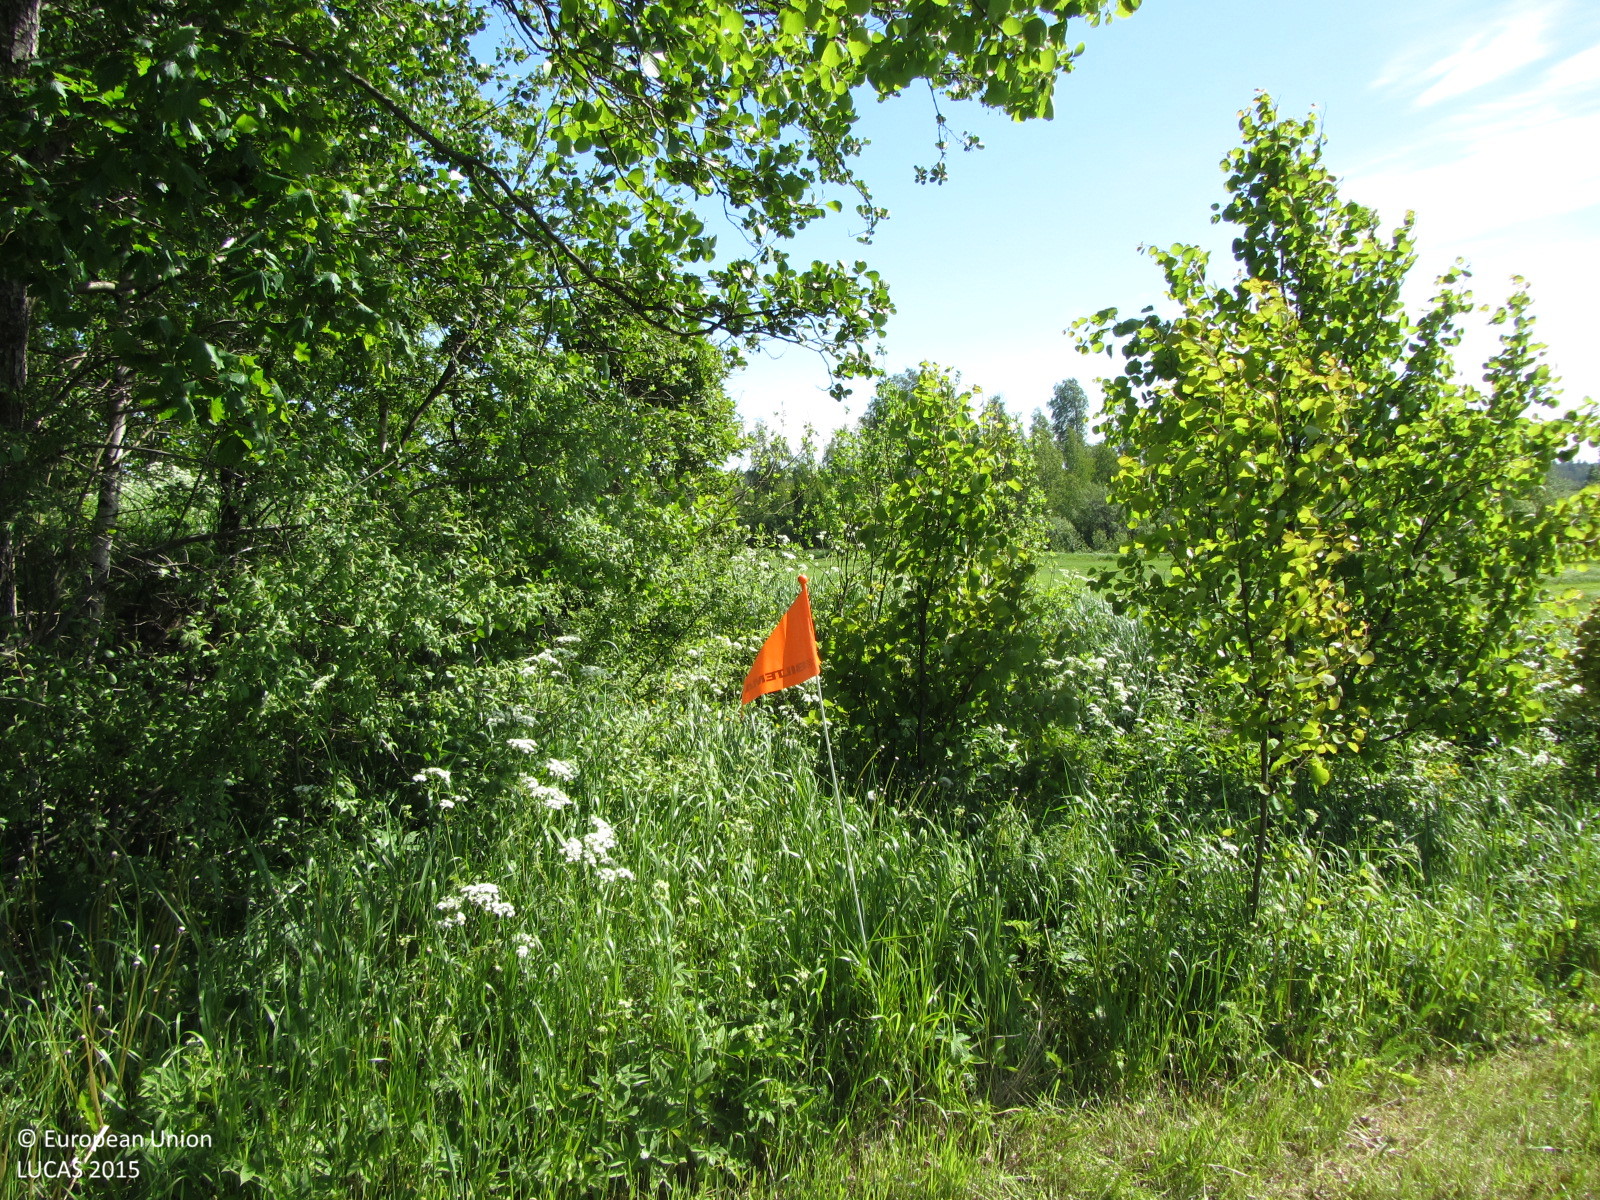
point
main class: Grassland
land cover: Grassland with sparse tree/shrub cover
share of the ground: > 75 %
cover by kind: herbaceous plants 90 %, broadleaved forest trees 5 %, shrubs 5 %
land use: Agriculture (excluding fallow land and kitchen gardens)
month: June
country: FI
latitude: 60.1986
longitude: 24.3005
